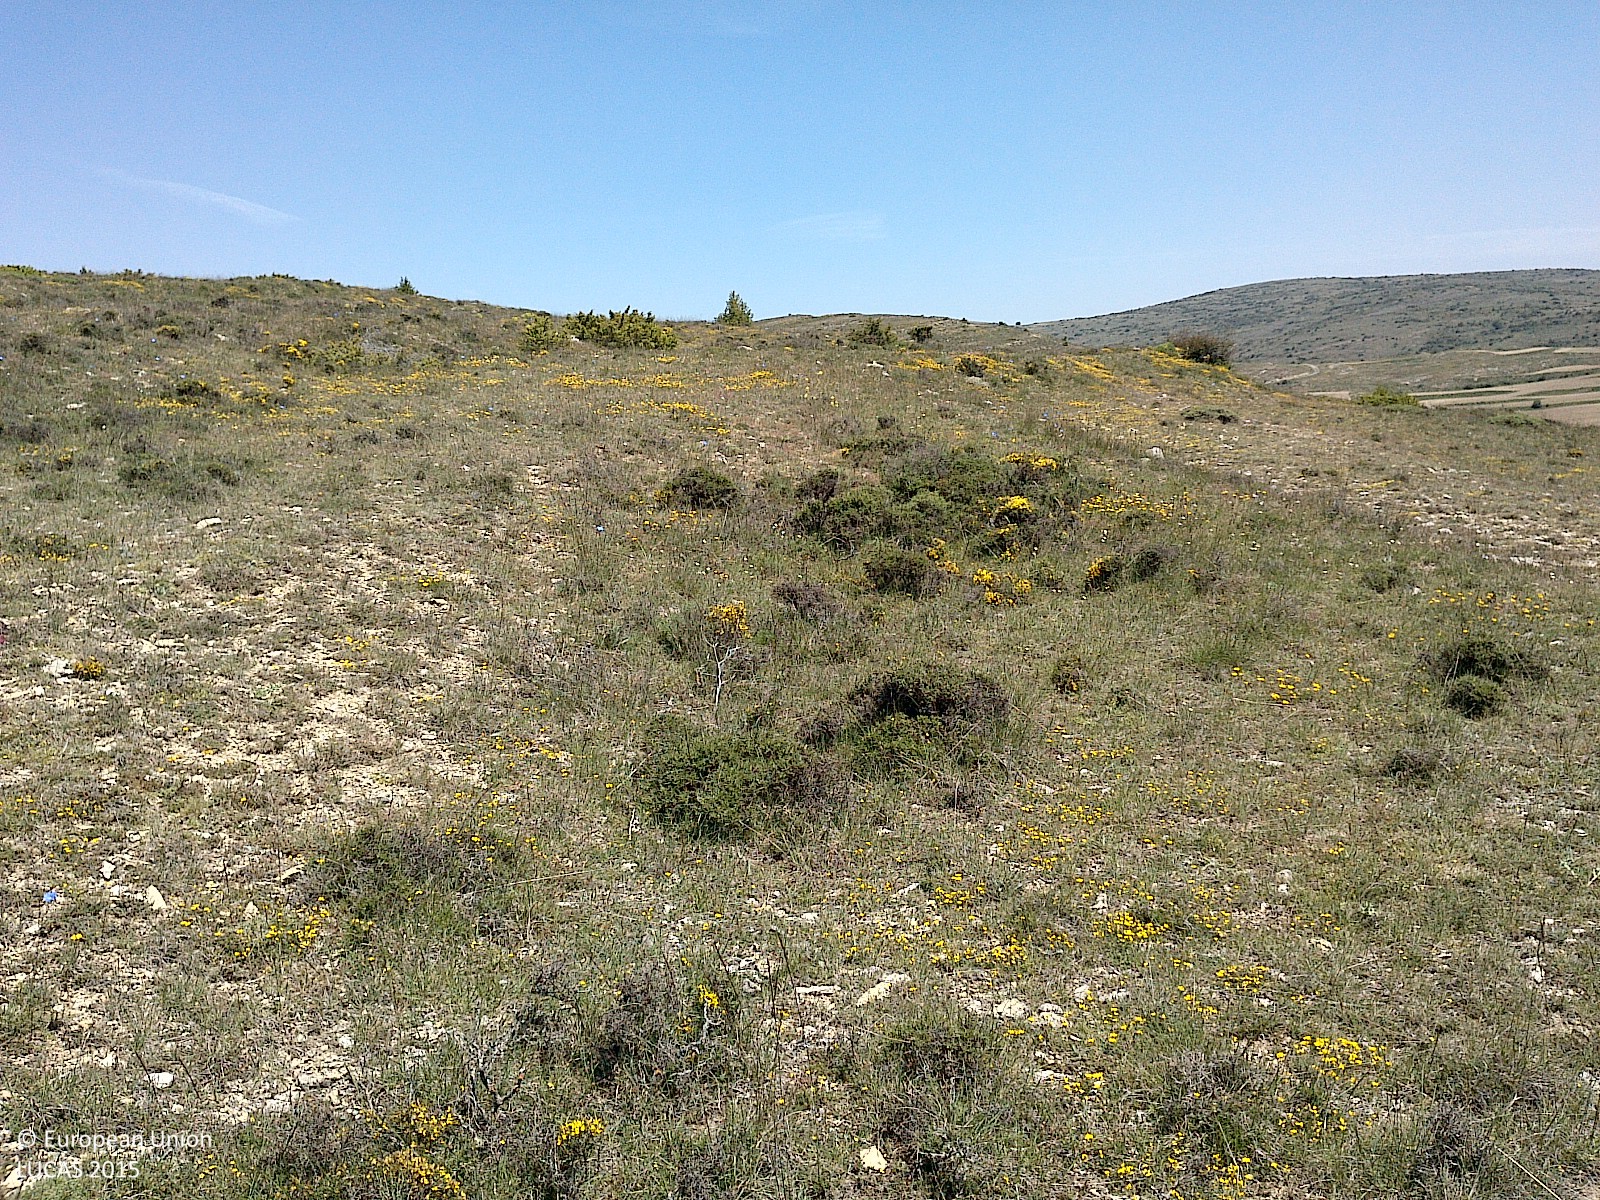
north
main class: Grassland
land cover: Grassland without tree/shrub cover
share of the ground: > 75 %
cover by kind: herbaceous plants 85 %, consolidated bare surface 10 %, shrubs 5 %
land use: Semi-natural and natural areas not in use
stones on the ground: < 10 %
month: May
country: ES
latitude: 41.8897
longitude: -2.2454
